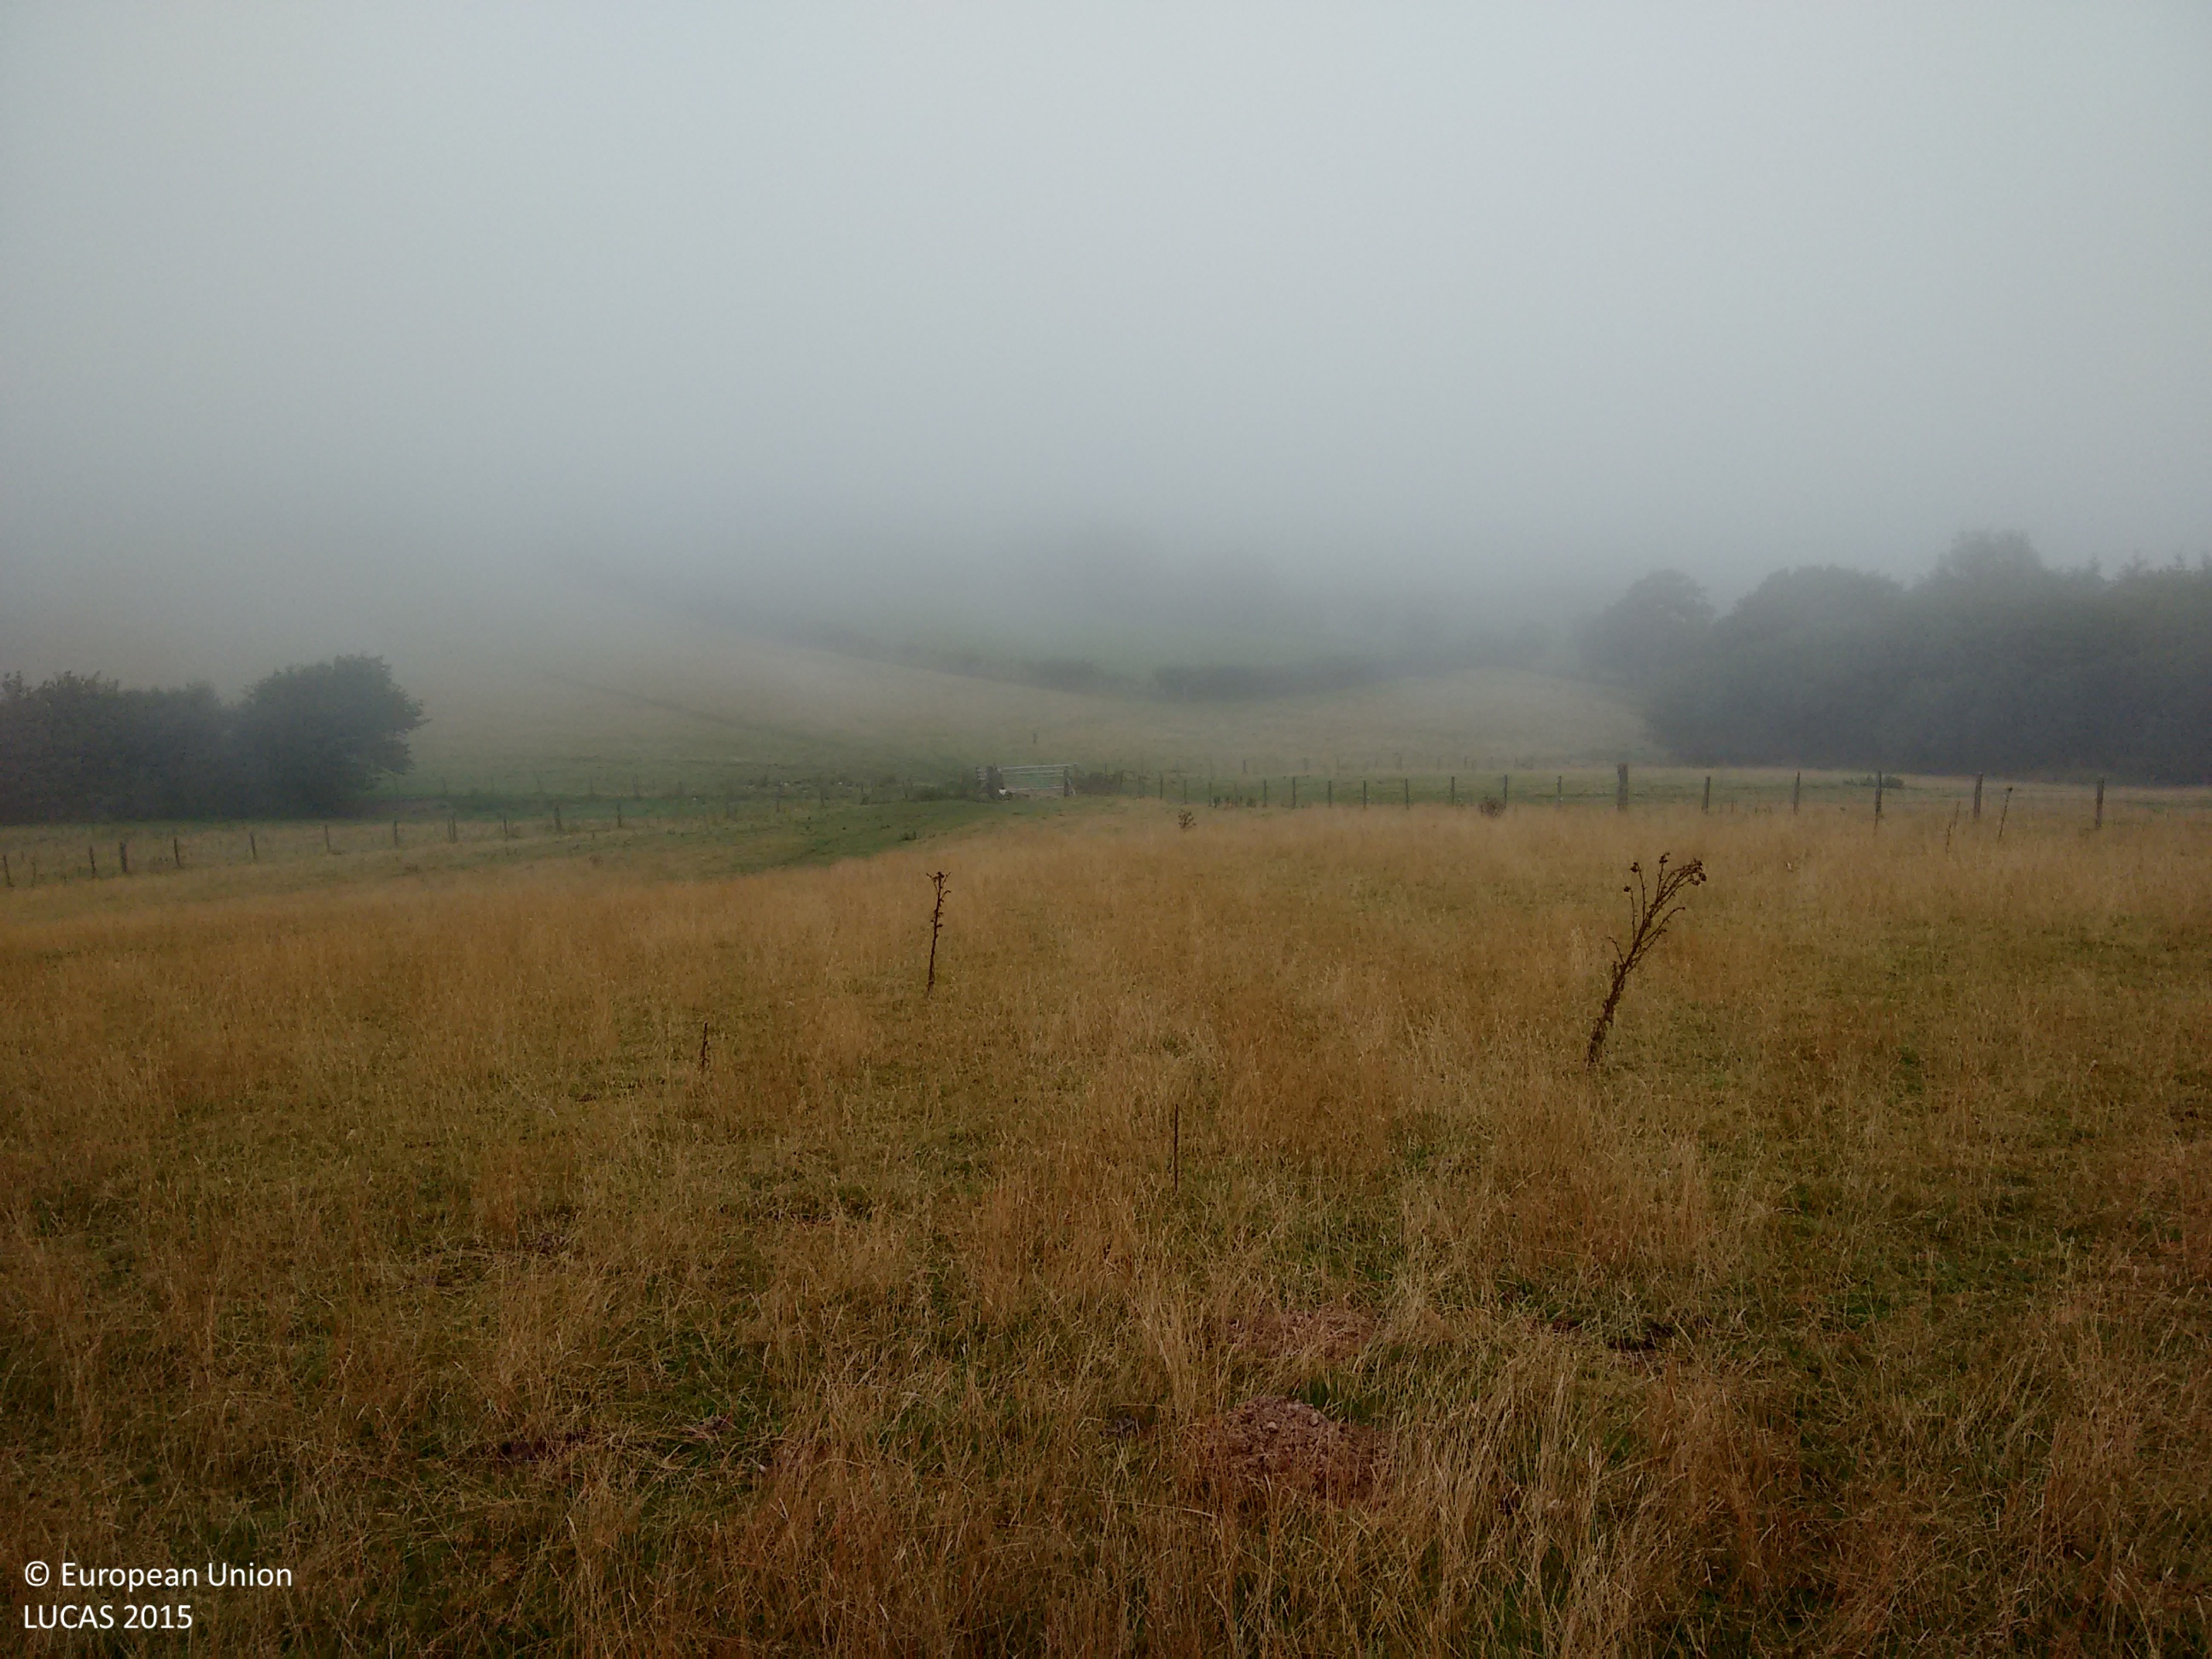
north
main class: Grassland
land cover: Grassland without tree/shrub cover
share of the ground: > 75 %
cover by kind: herbaceous plants 100 %
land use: Agriculture (excluding fallow land and kitchen gardens)
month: September
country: GB
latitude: 52.1688
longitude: -3.1639
